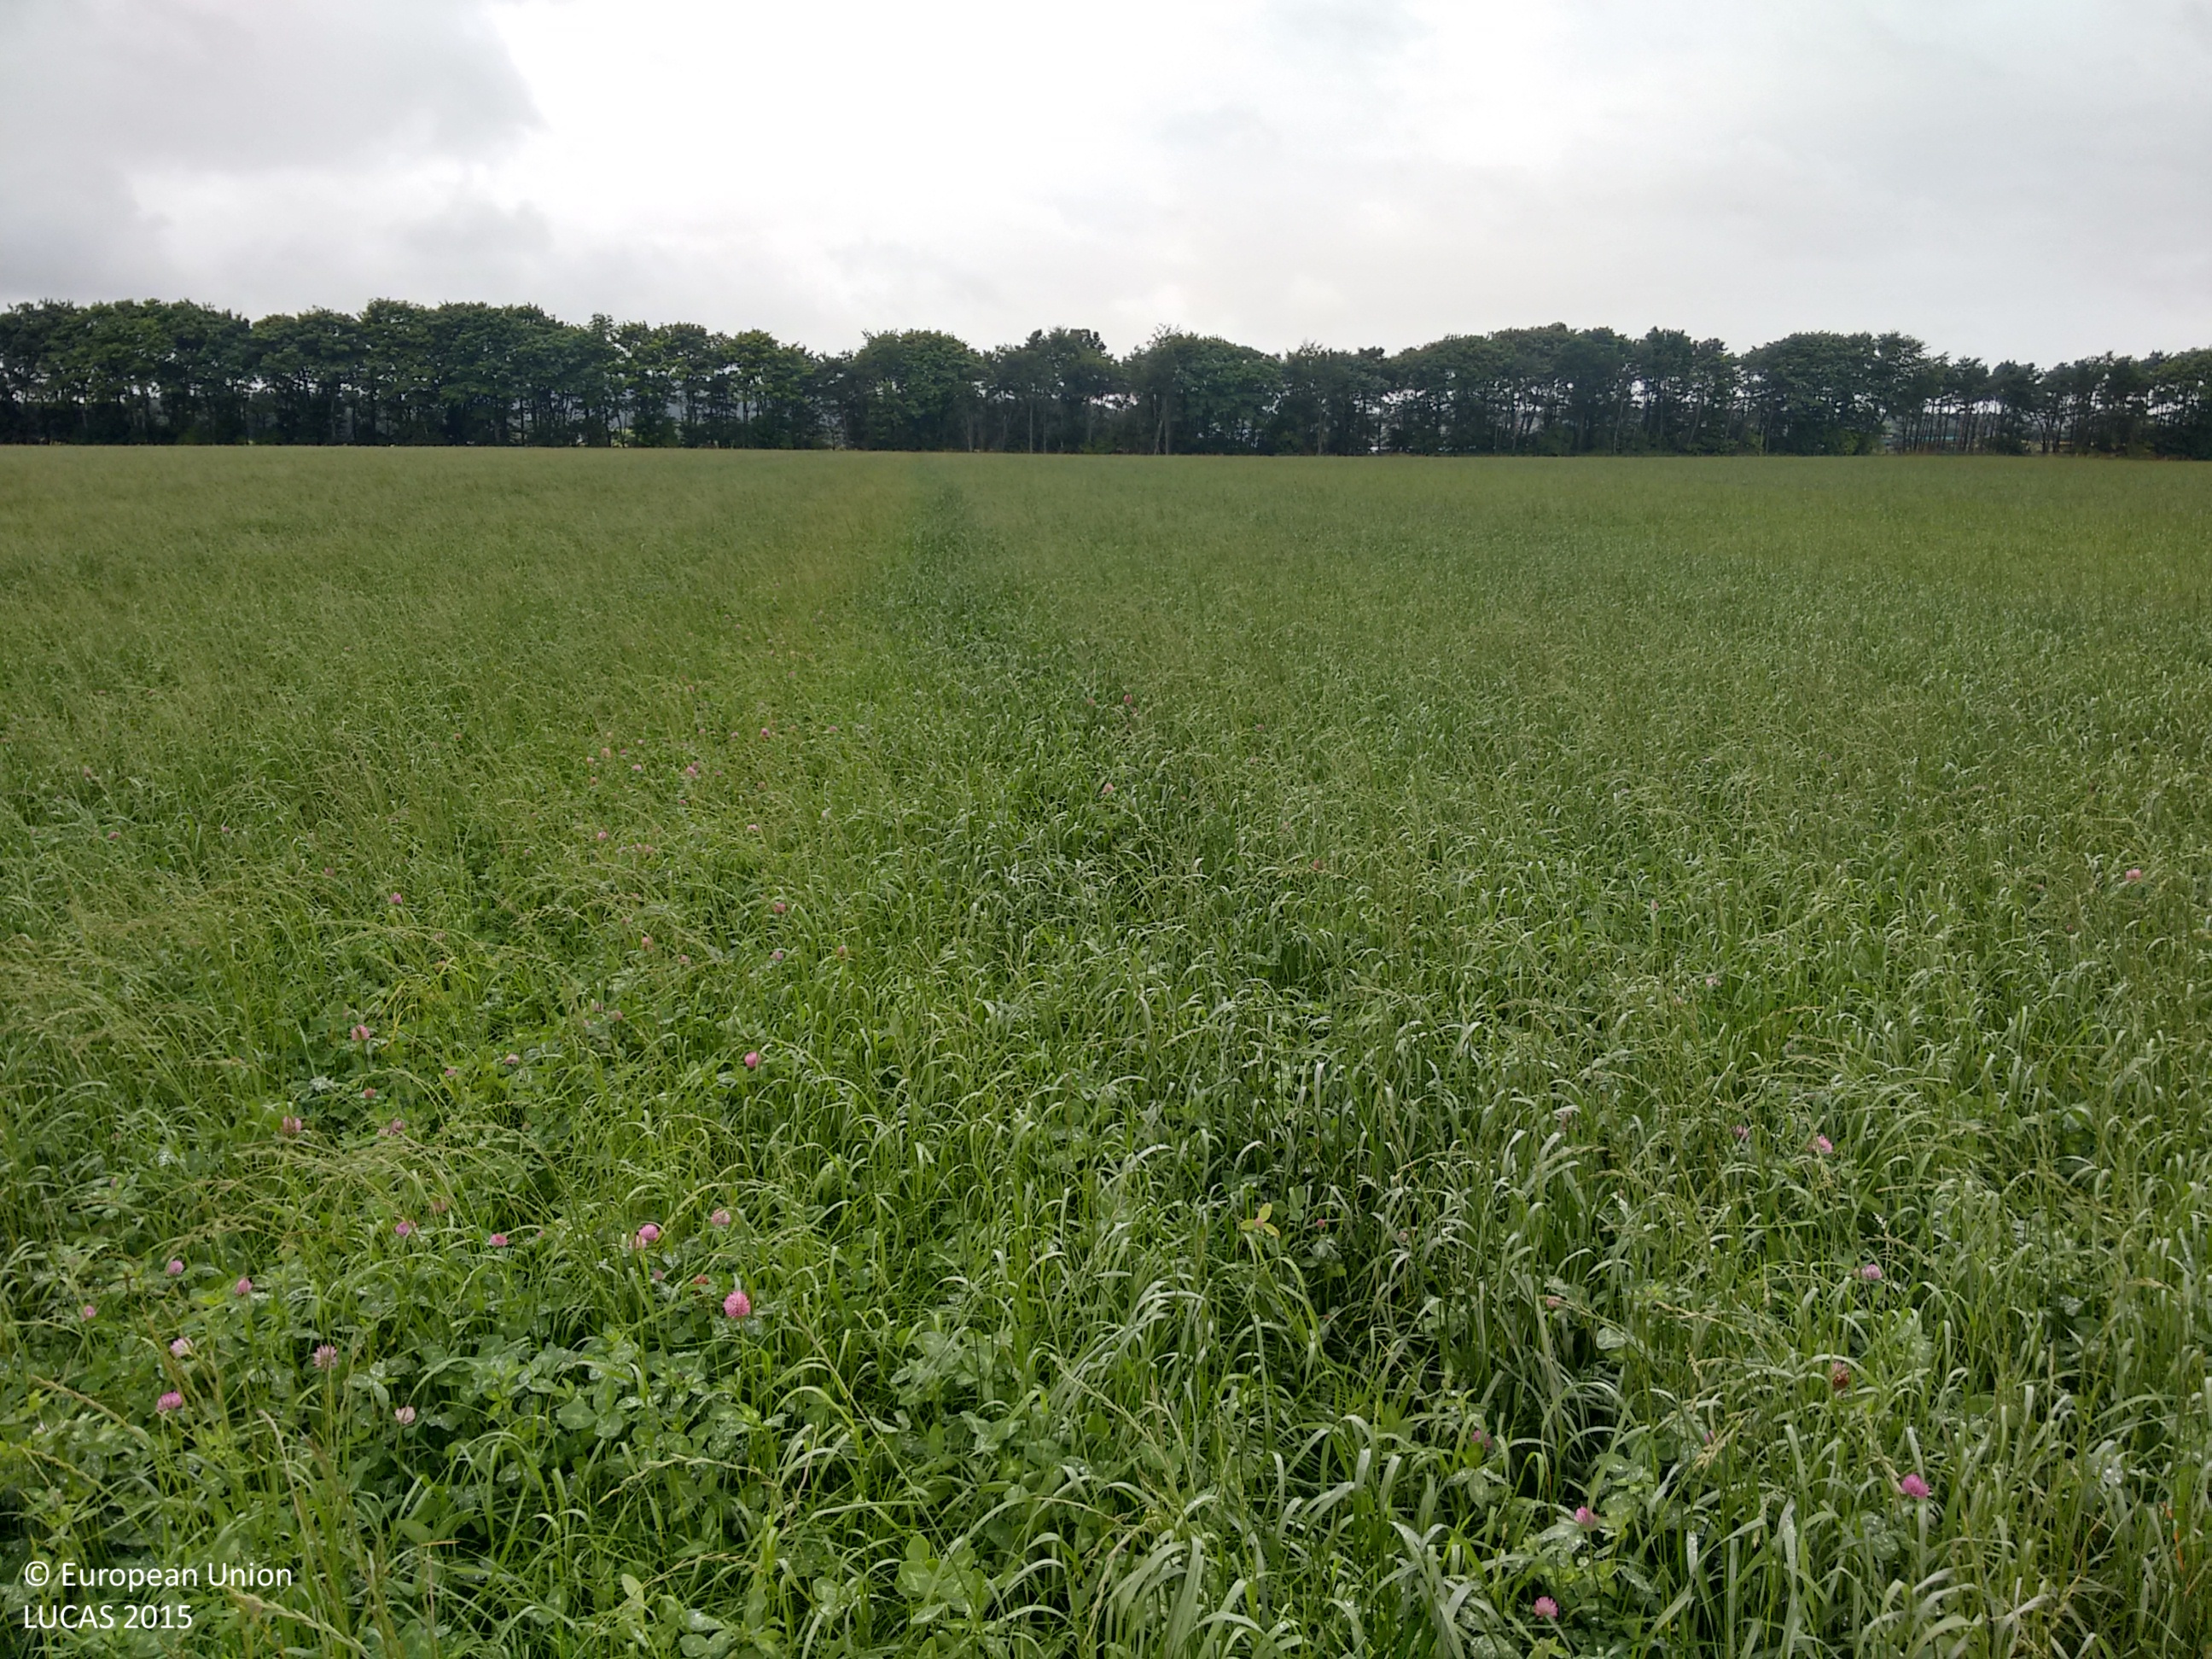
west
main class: Cropland
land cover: Temporary grasslands
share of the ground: > 75 %
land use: Agriculture (excluding fallow land and kitchen gardens)
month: September
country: GB
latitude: 57.6231
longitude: -3.3445
